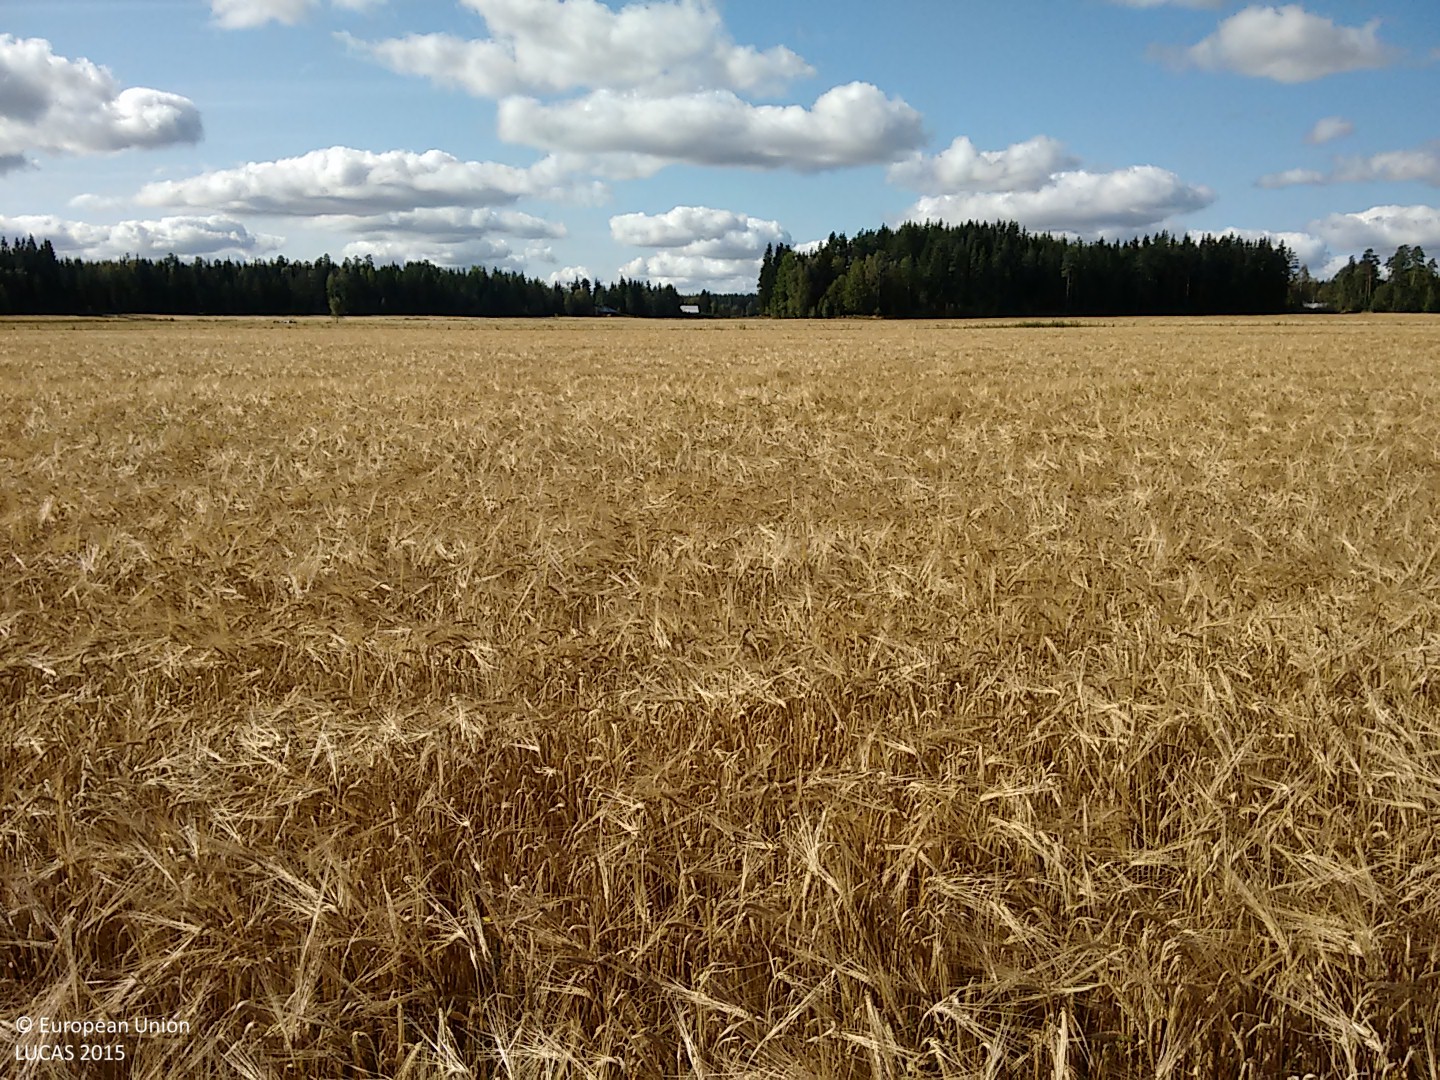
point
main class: Cropland
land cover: Barley
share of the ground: > 75 %
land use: Agriculture (excluding fallow land and kitchen gardens)
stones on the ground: < 10 %
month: September
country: FI
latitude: 60.8697
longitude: 21.7887
